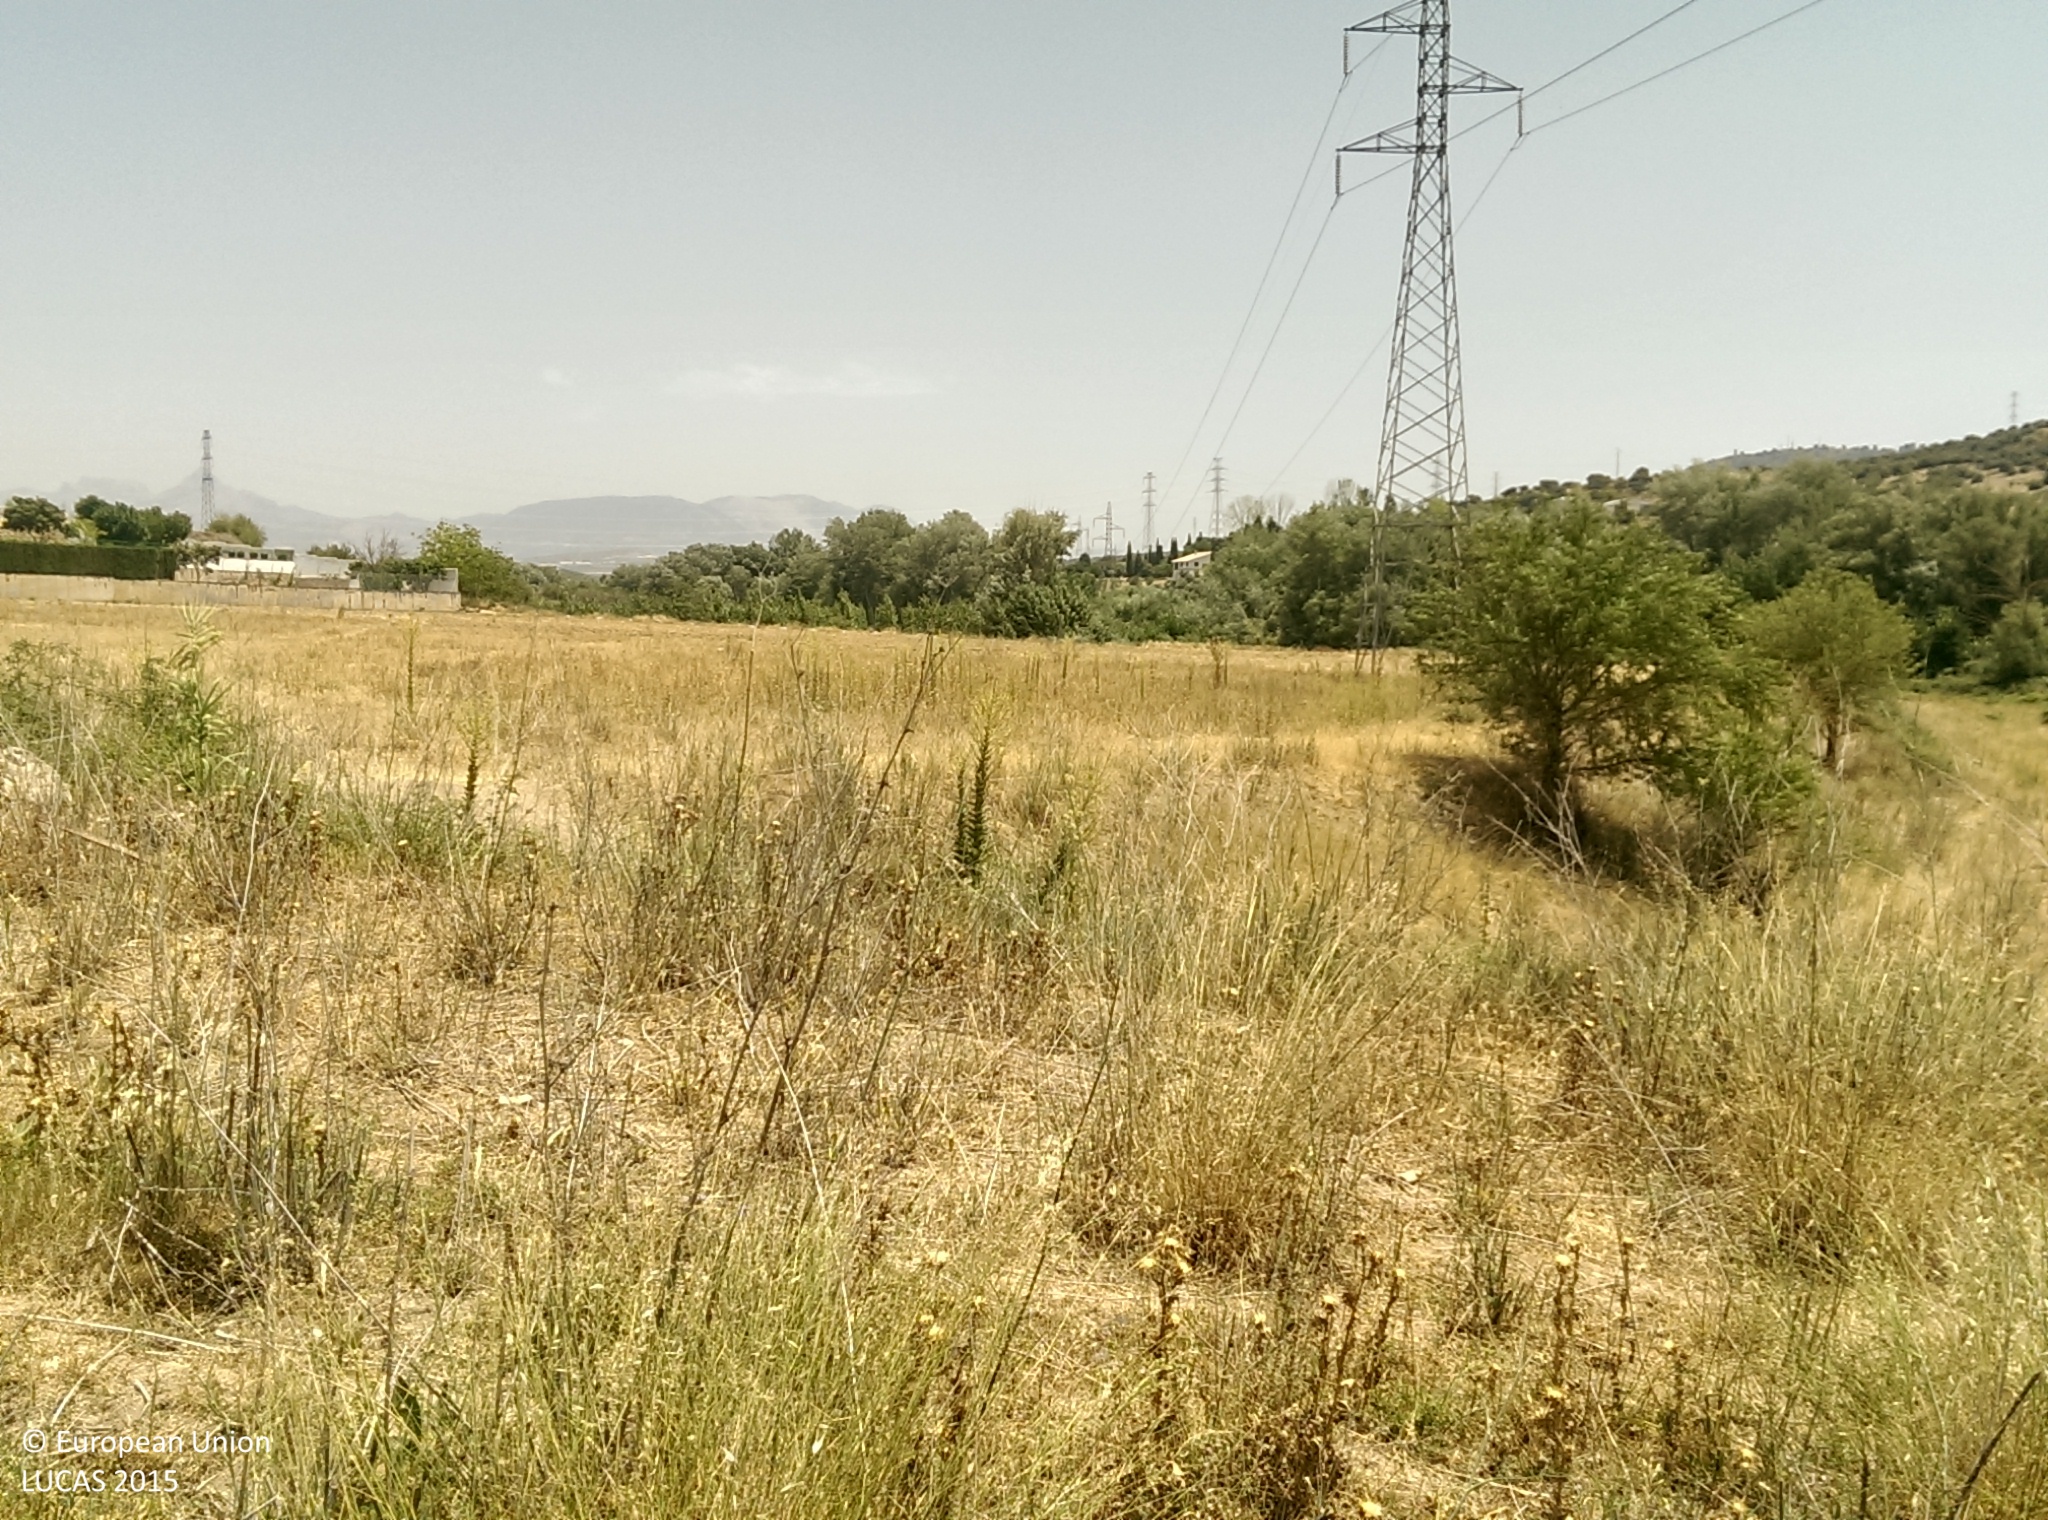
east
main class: Grassland
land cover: Spontaneously vegetated surfaces
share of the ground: > 75 %
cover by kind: herbaceous plants 90 %, unconsolidated bare surface 10 %
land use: Fallow land
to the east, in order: Spontaneously vegetated surfaces; Ditches and canals; Tracks; Electric lines; Spontaneously vegetated surfaces; Other bare soil; Grass margins; Tracks; Grassland with sparse tree/shrub cover; Broadleaved woodland
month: July
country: ES
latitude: 37.2630
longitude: -3.7146
